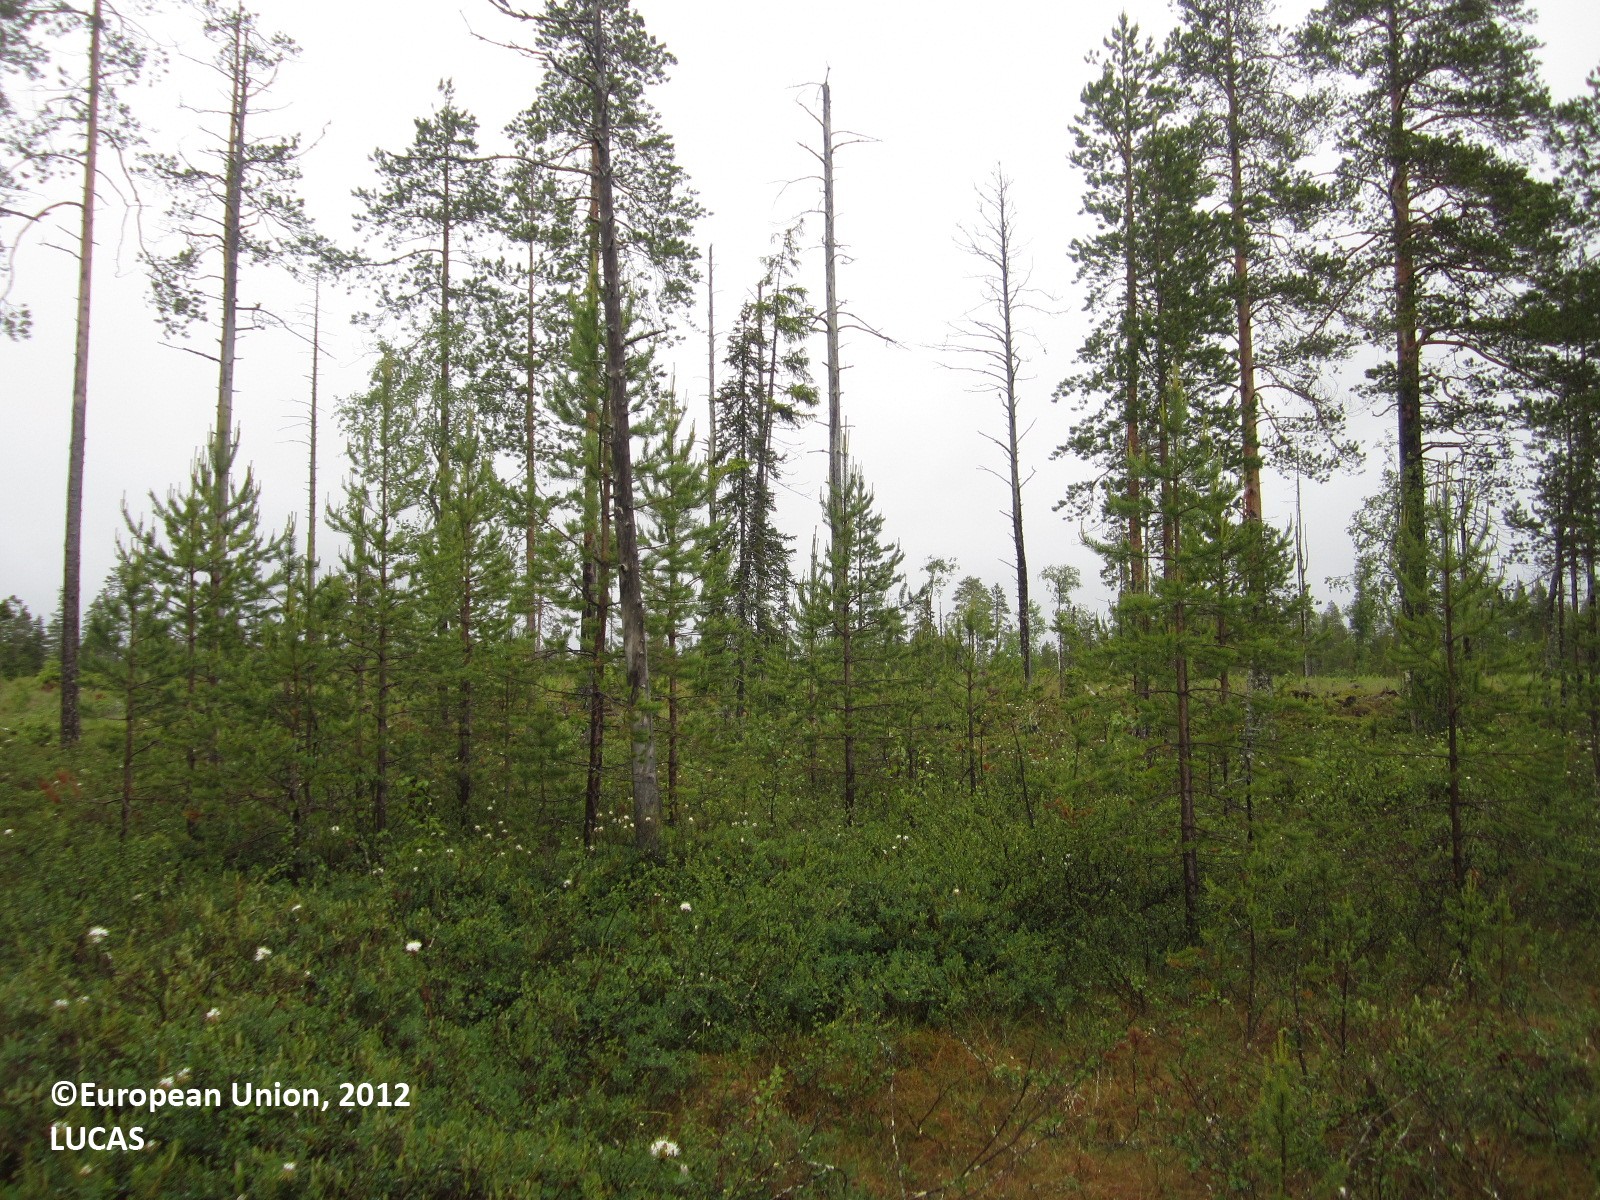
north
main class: Woodland
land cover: Pine dominated coniferous woodland
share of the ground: 50 - 75 %
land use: Forestry
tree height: > 5 m
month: June
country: FI
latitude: 64.6189
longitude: 30.0348
